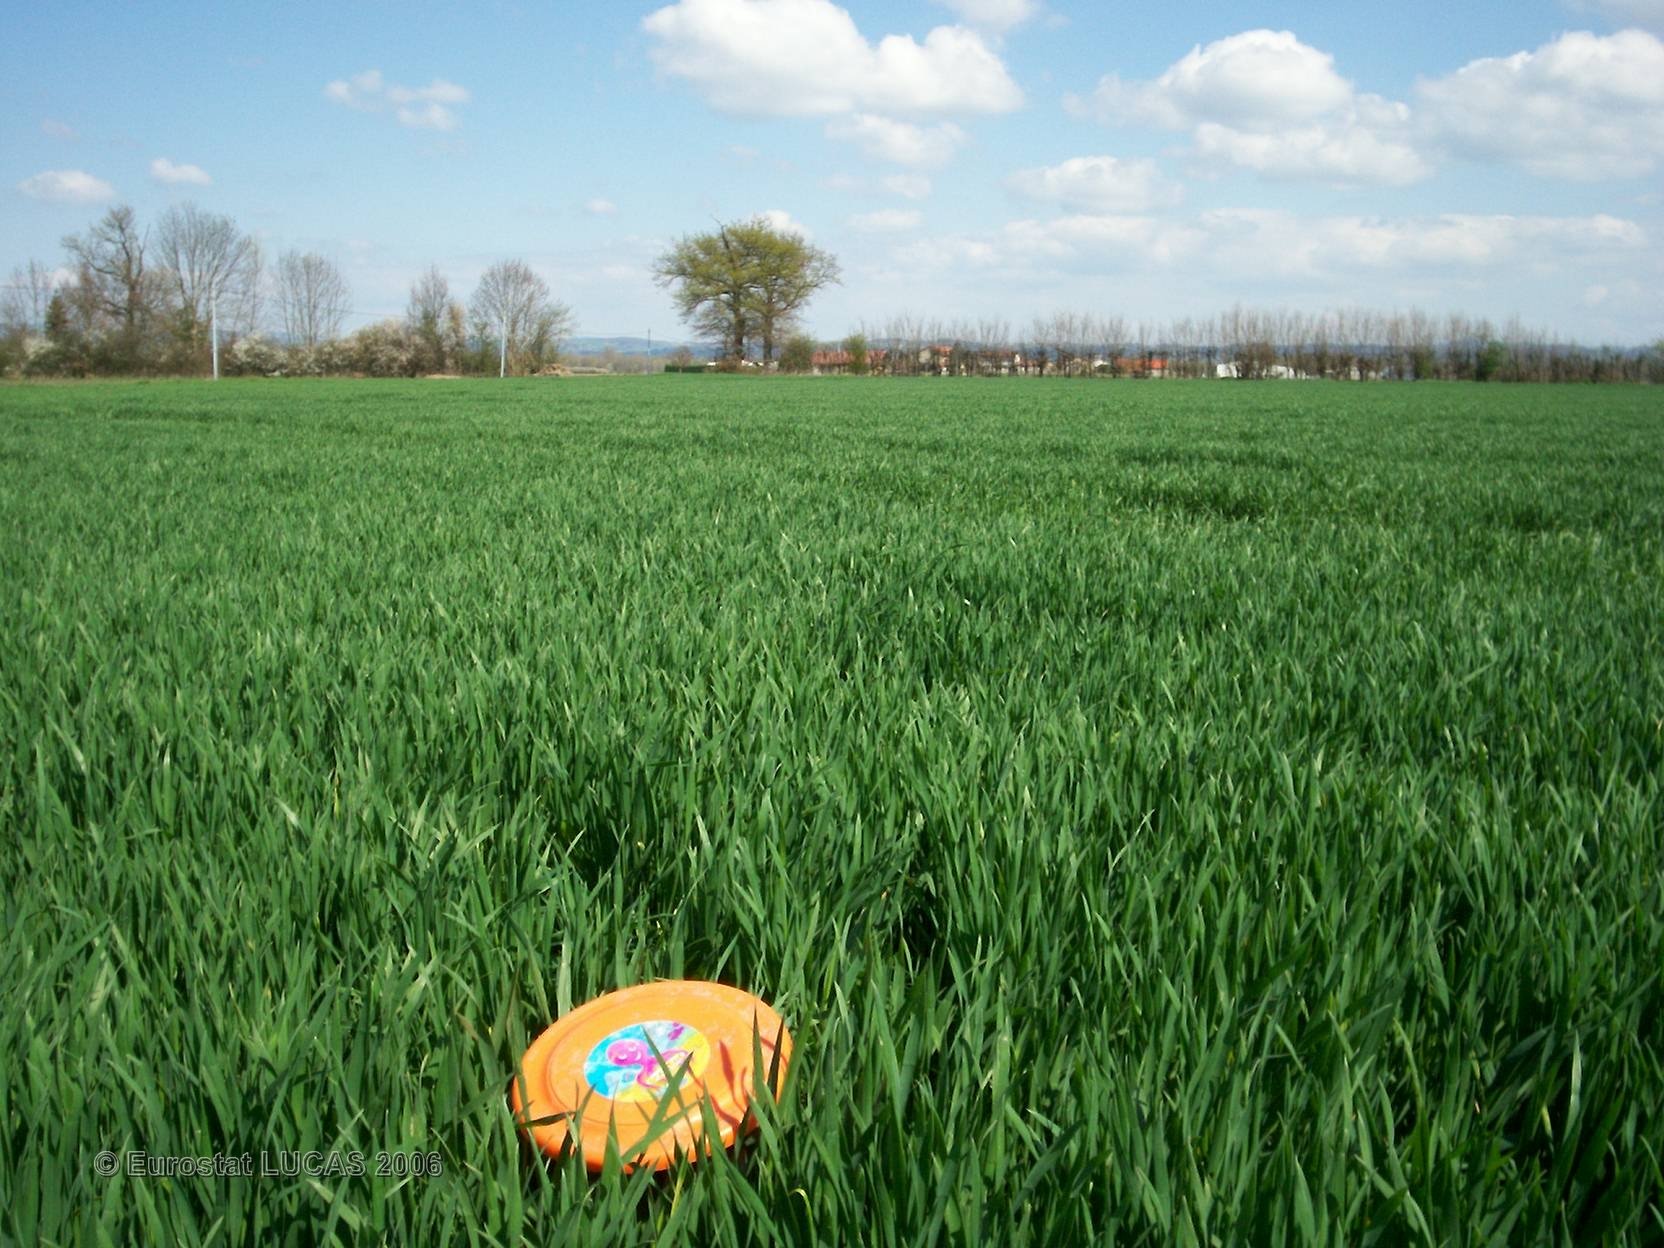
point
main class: Cropland
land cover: Common wheat
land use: Agriculture (excluding fallow land and kitchen gardens)
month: April
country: FR
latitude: 45.7054
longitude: 4.1842
